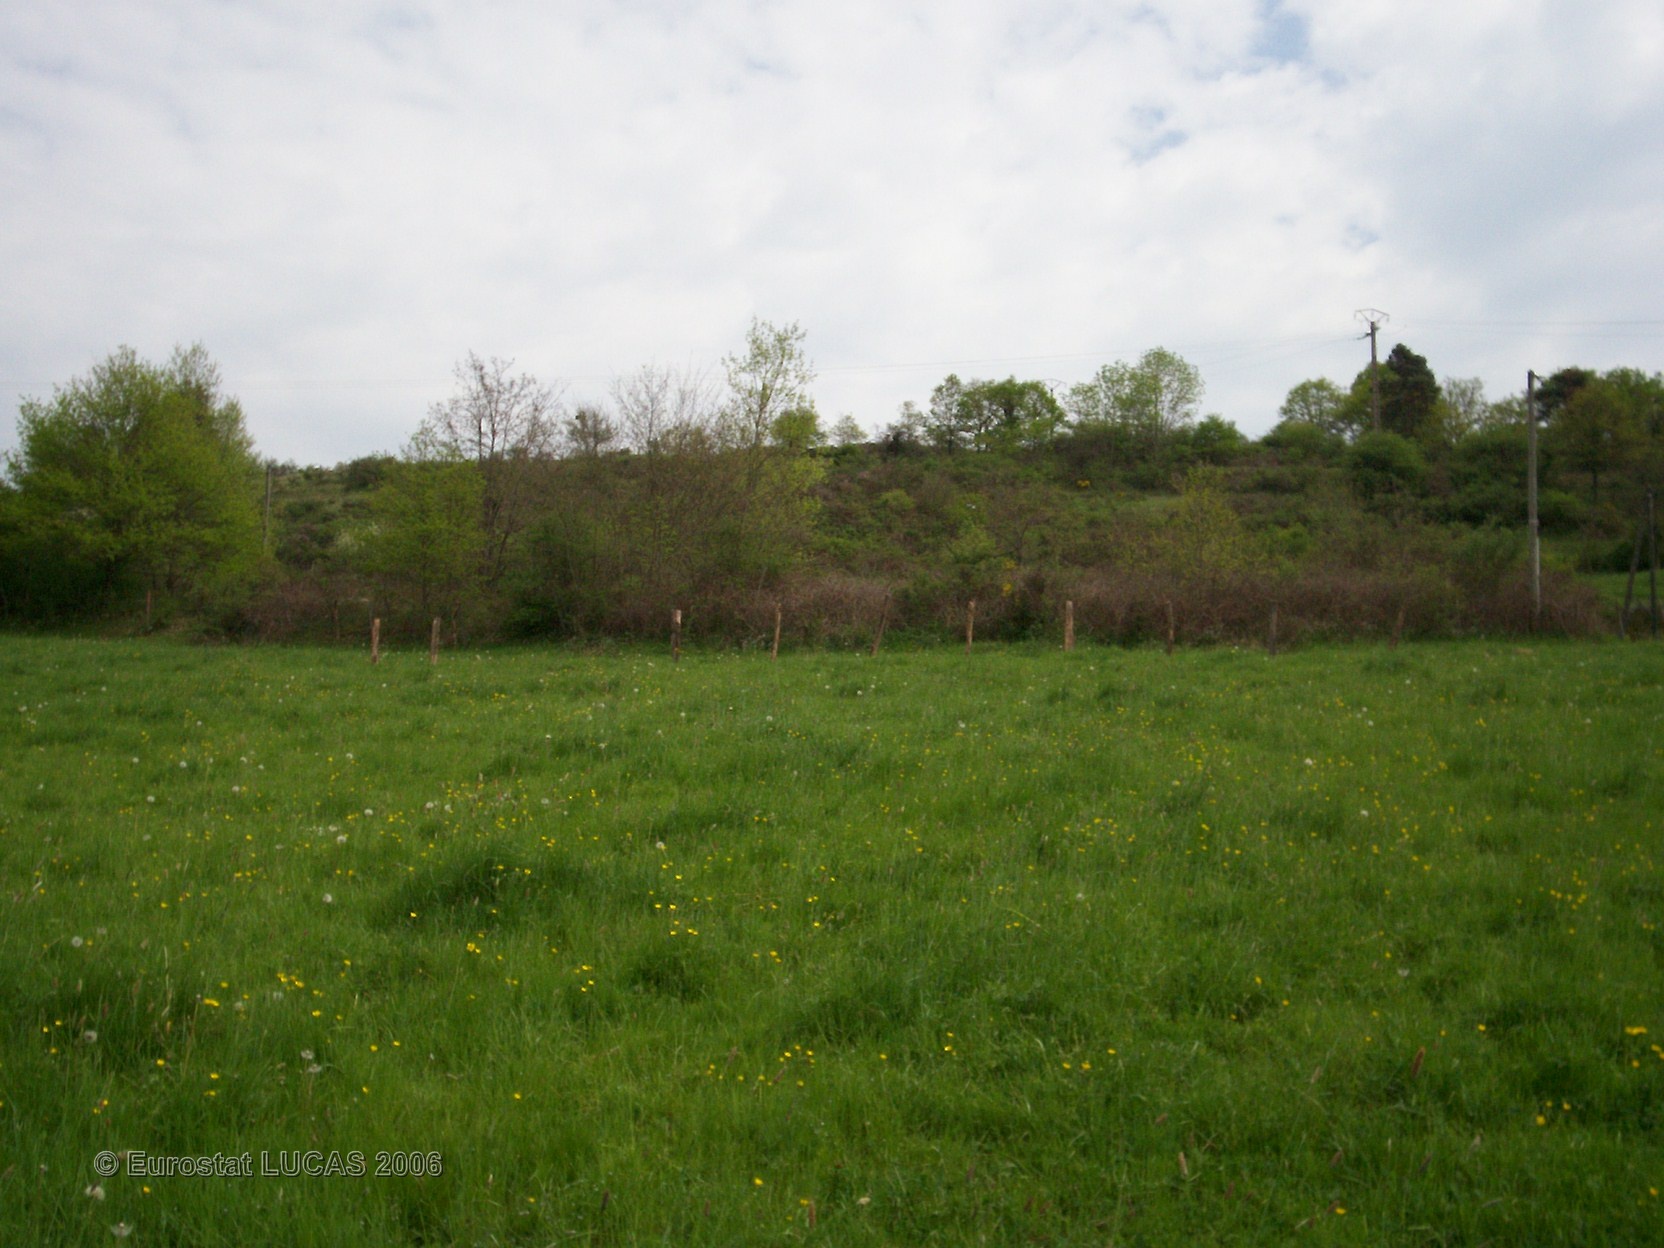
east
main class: Grassland
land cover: Grassland without tree/shrub cover
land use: Agriculture (excluding fallow land and kitchen gardens)
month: May
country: FR
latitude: 45.8821
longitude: 4.1136
